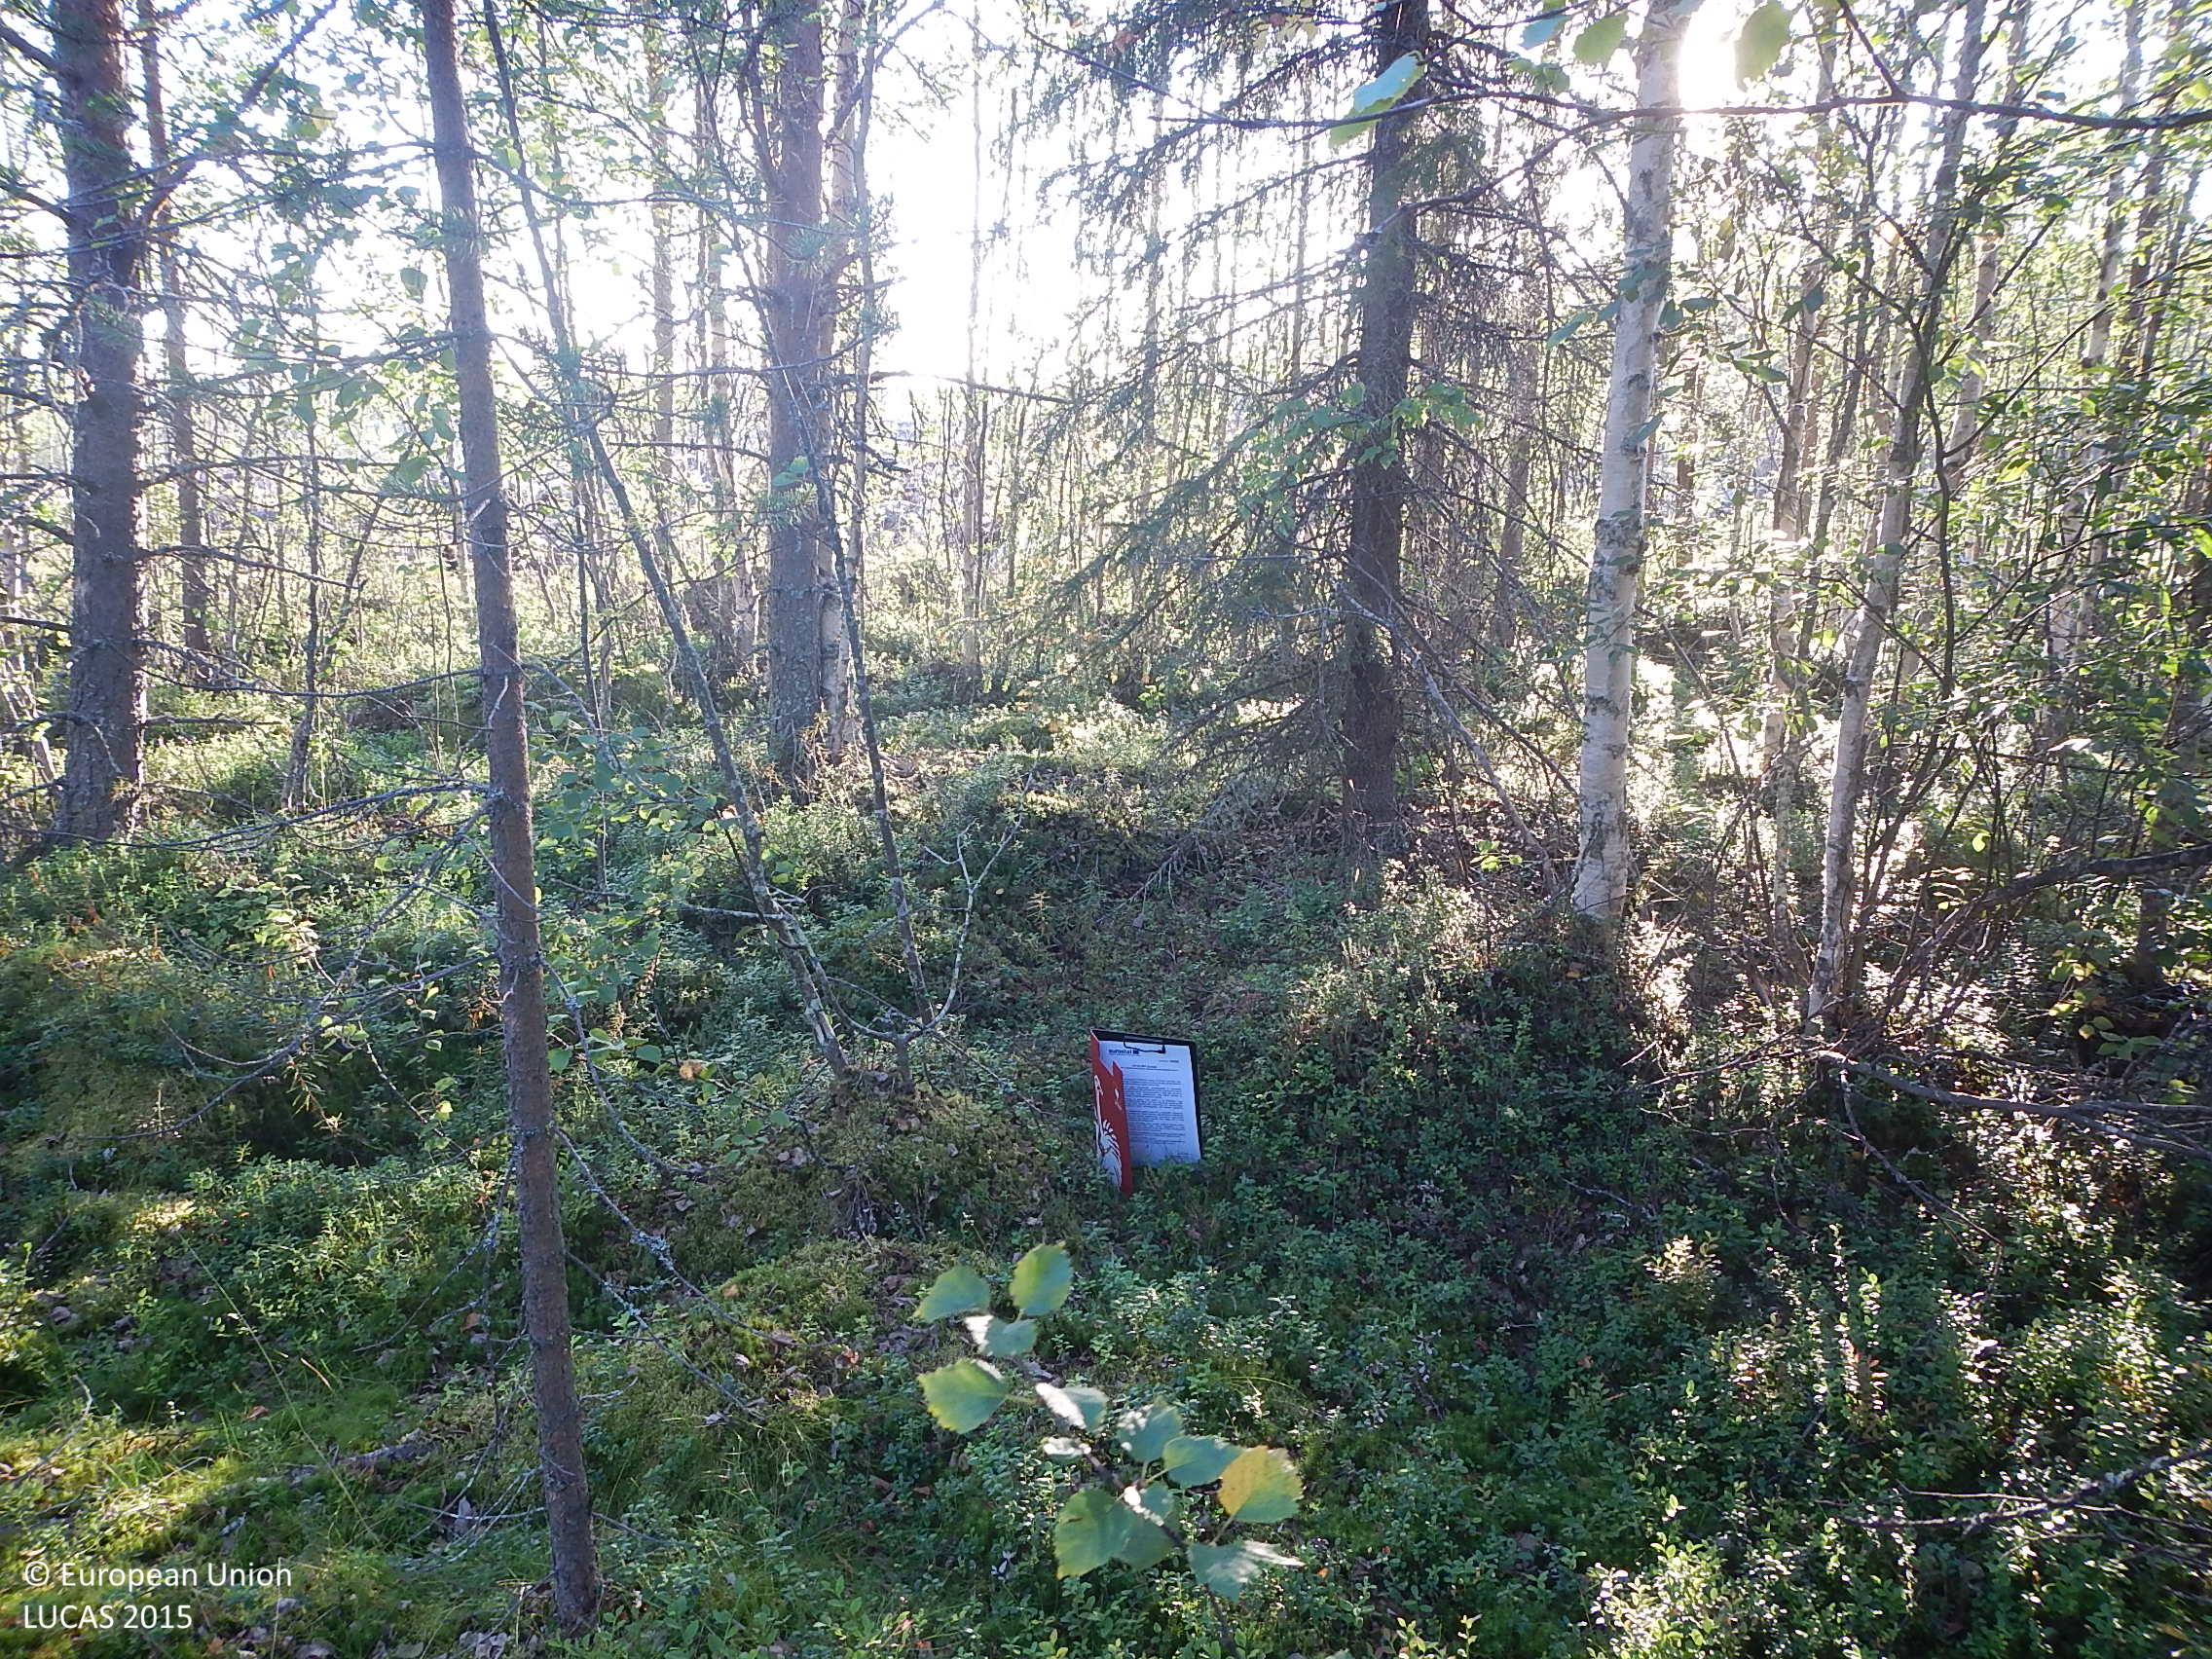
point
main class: Woodland
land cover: Pine dominated mixed woodland
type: boreal forest
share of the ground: > 75 %
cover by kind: coniferous forest trees 50 %, broadleaved forest trees 30 %, shrubs 10 %, lichens and mosses 10 %
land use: Forestry
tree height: > 5 m
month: August
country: FI
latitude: 66.4516
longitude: 28.1930
